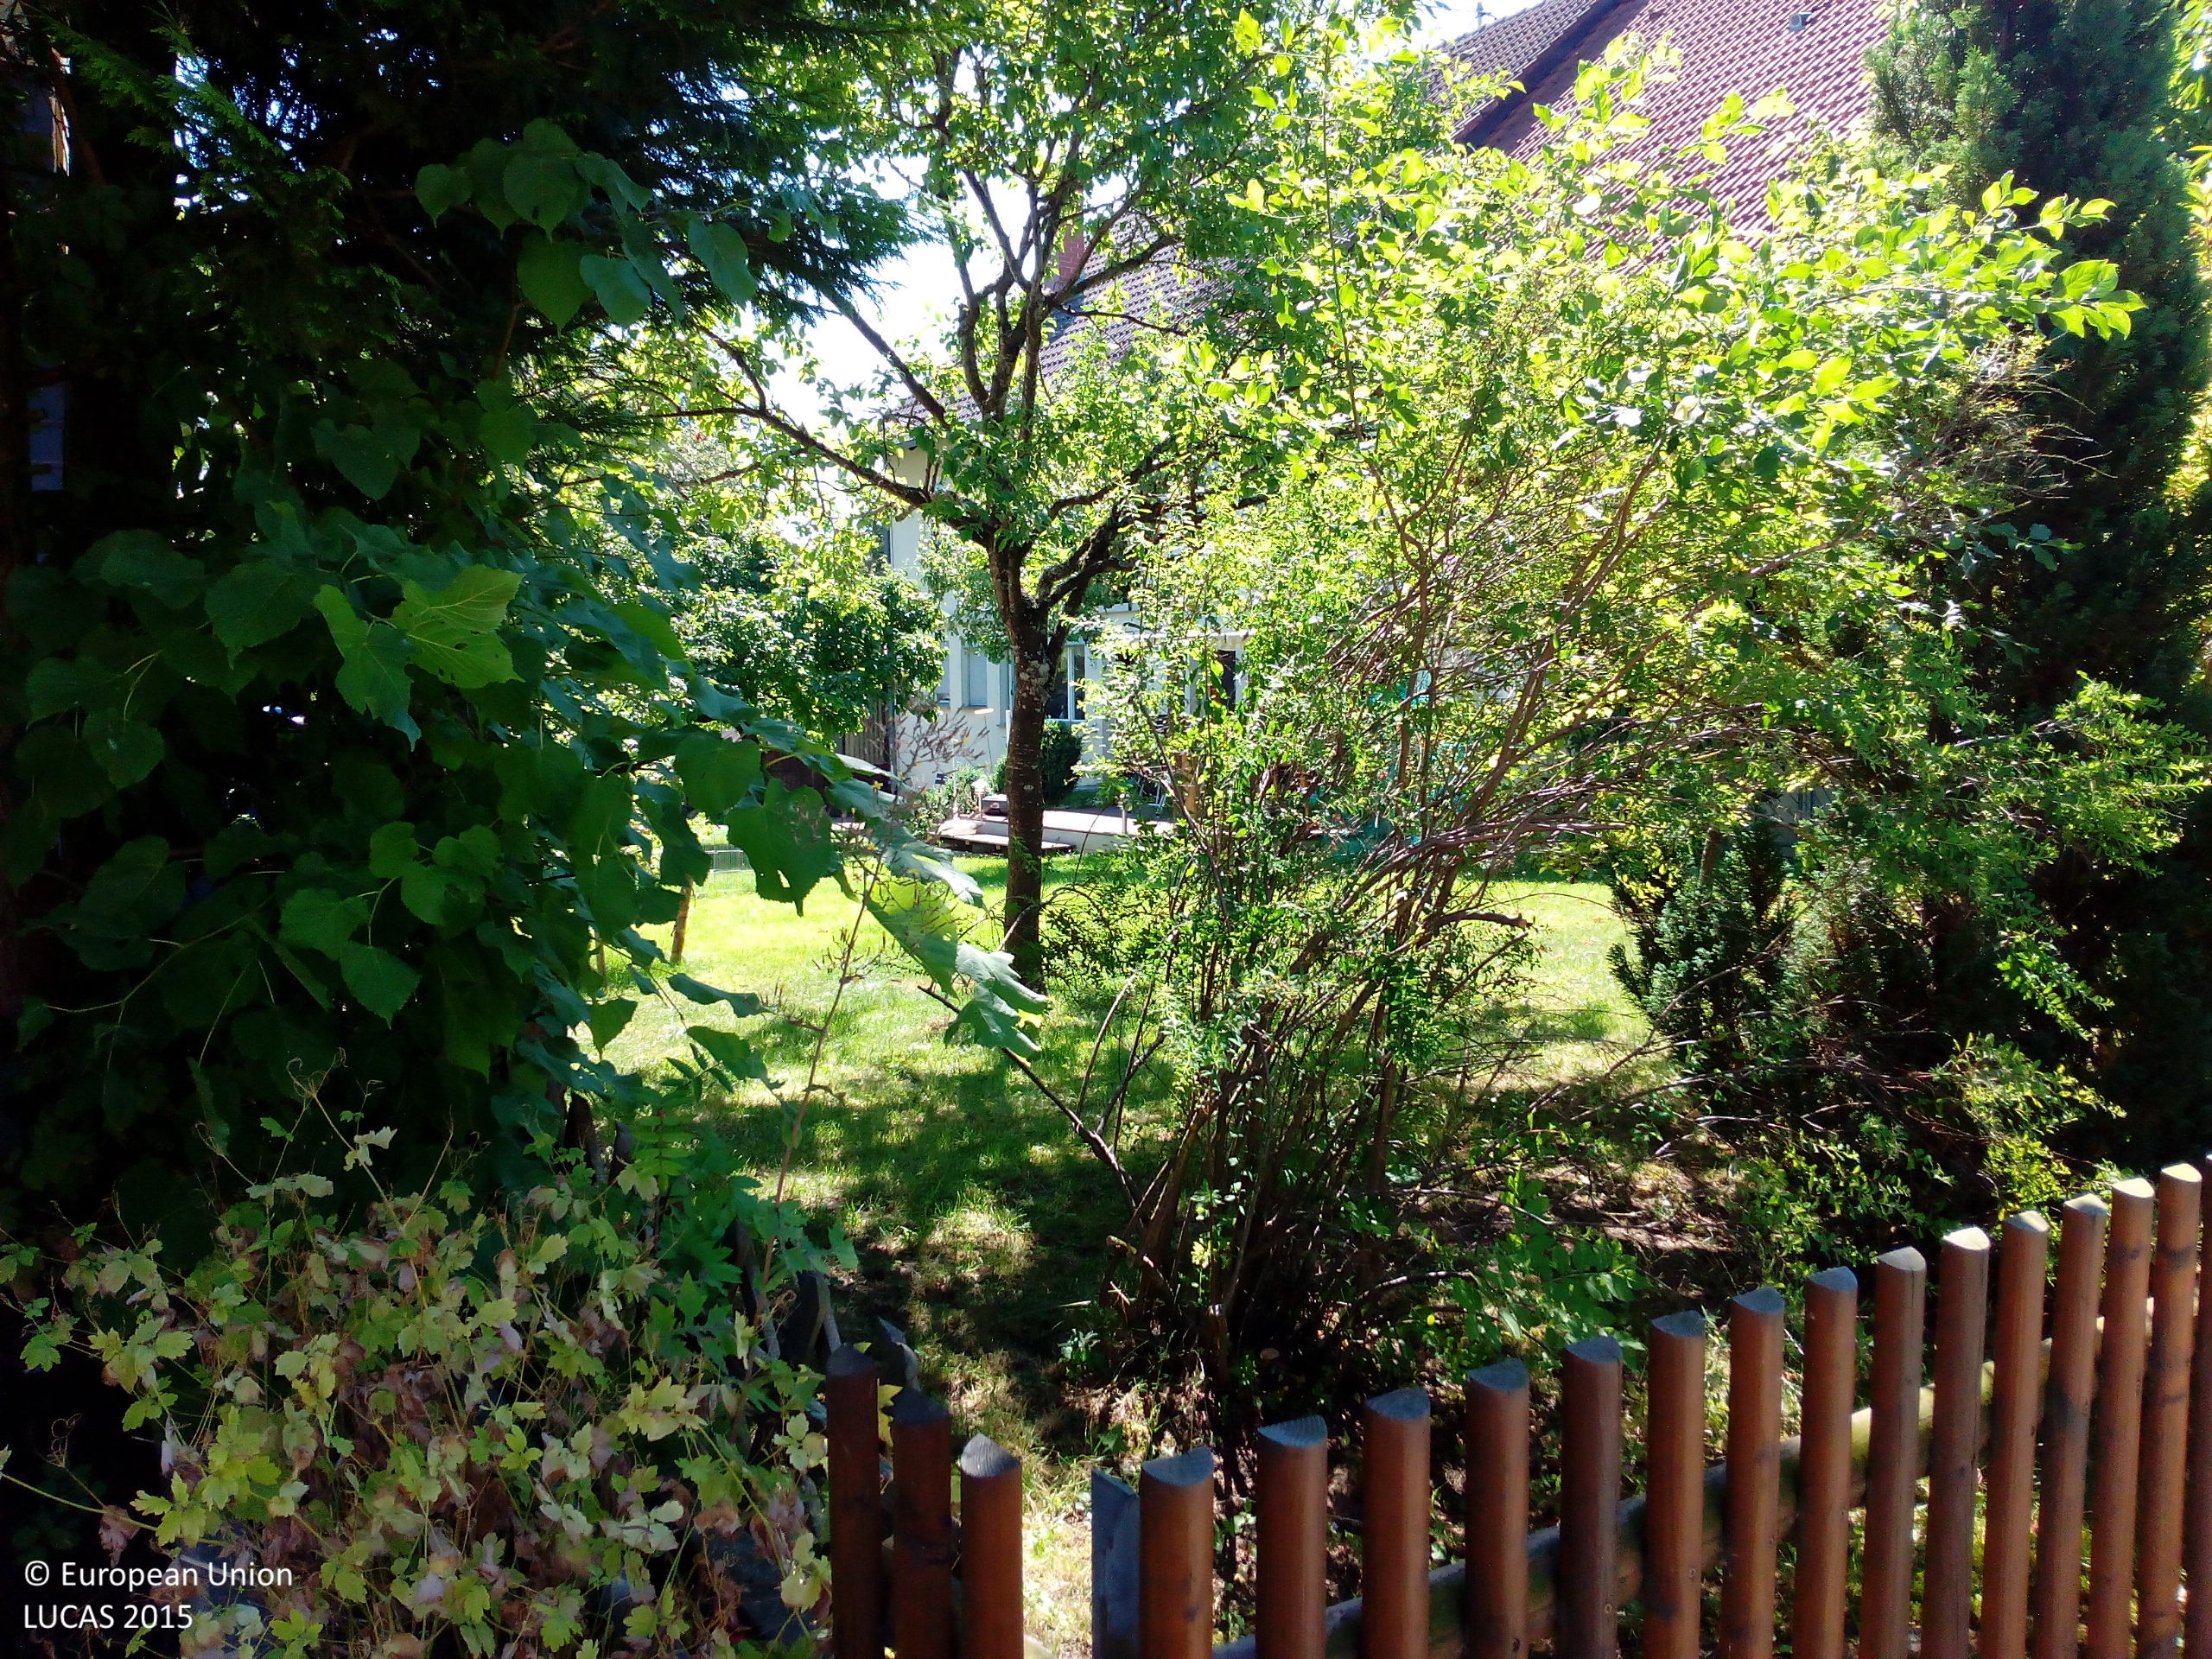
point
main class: Cropland
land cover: Pear fruit
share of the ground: 25 - 50 %
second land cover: Grassland without tree/shrub cover
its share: > 75 %
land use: Kitchen garden
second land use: Residential
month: July
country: DE
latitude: 47.8200
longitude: 8.7054
